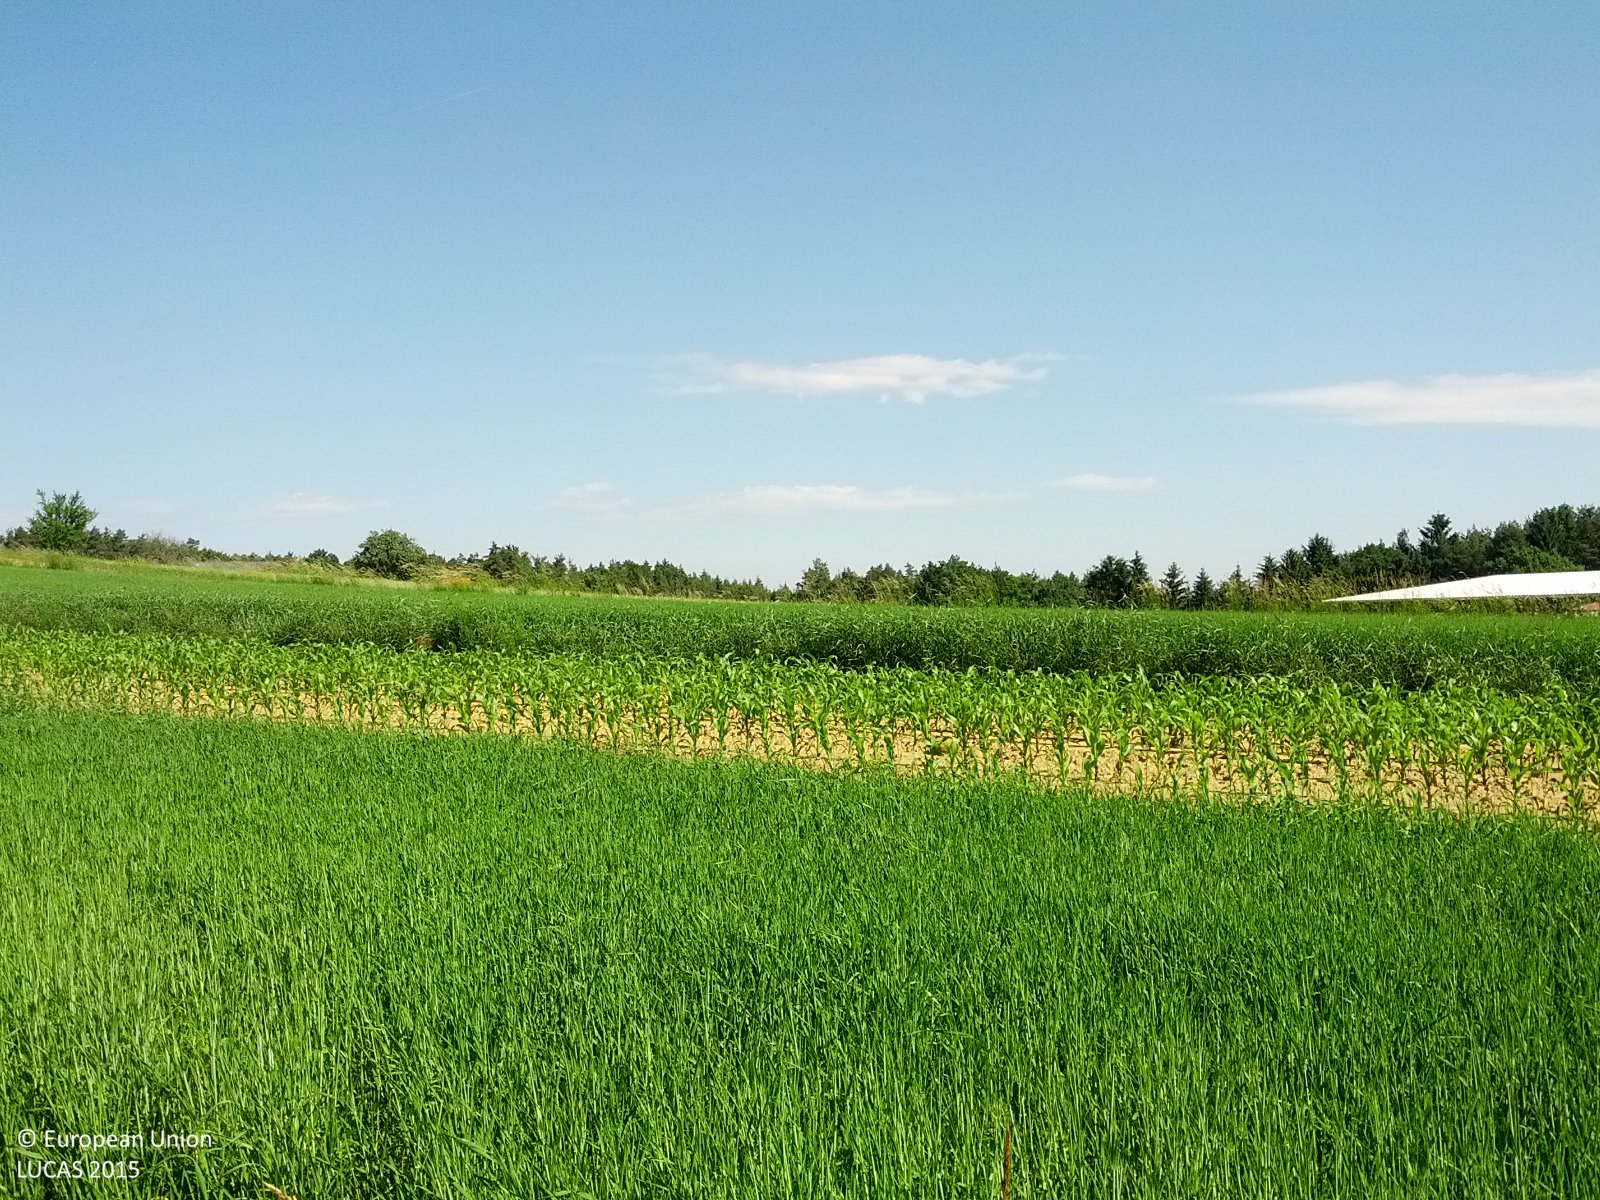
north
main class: Grassland
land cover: Grassland without tree/shrub cover
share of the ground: > 75 %
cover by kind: herbaceous plants 100 %
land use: Agriculture (excluding fallow land and kitchen gardens)
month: June
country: AT
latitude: 47.1861
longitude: 16.1384
